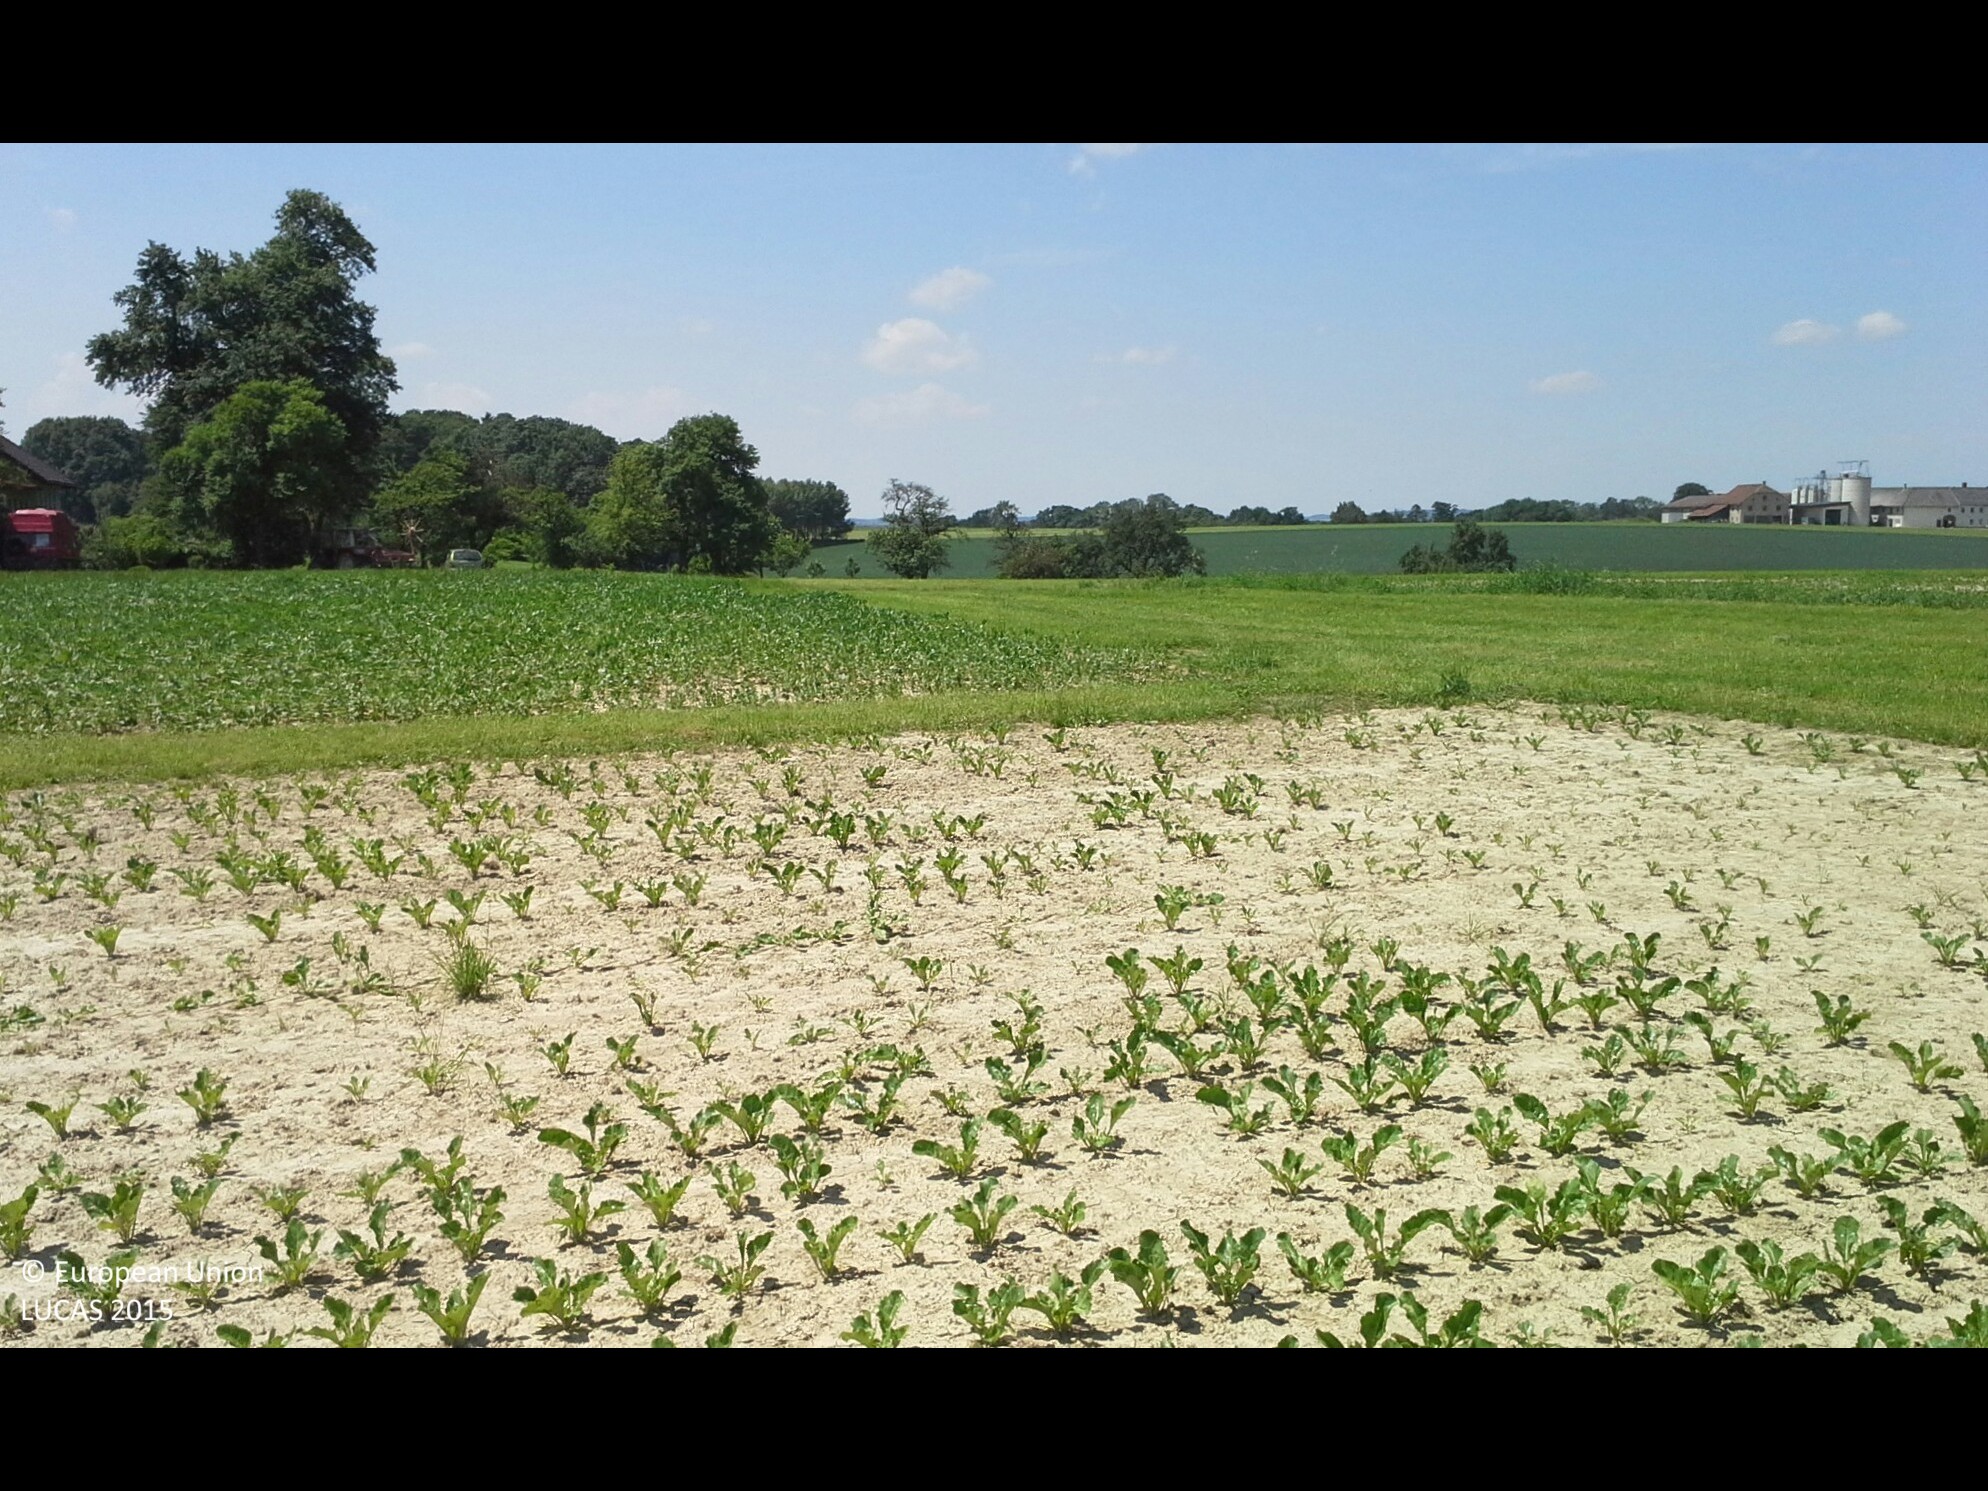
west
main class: Cropland
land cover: Sugar beet
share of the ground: 10 - 25 %
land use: Agriculture (excluding fallow land and kitchen gardens)
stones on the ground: < 10 %
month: June
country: AT
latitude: 48.1317
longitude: 14.5015
